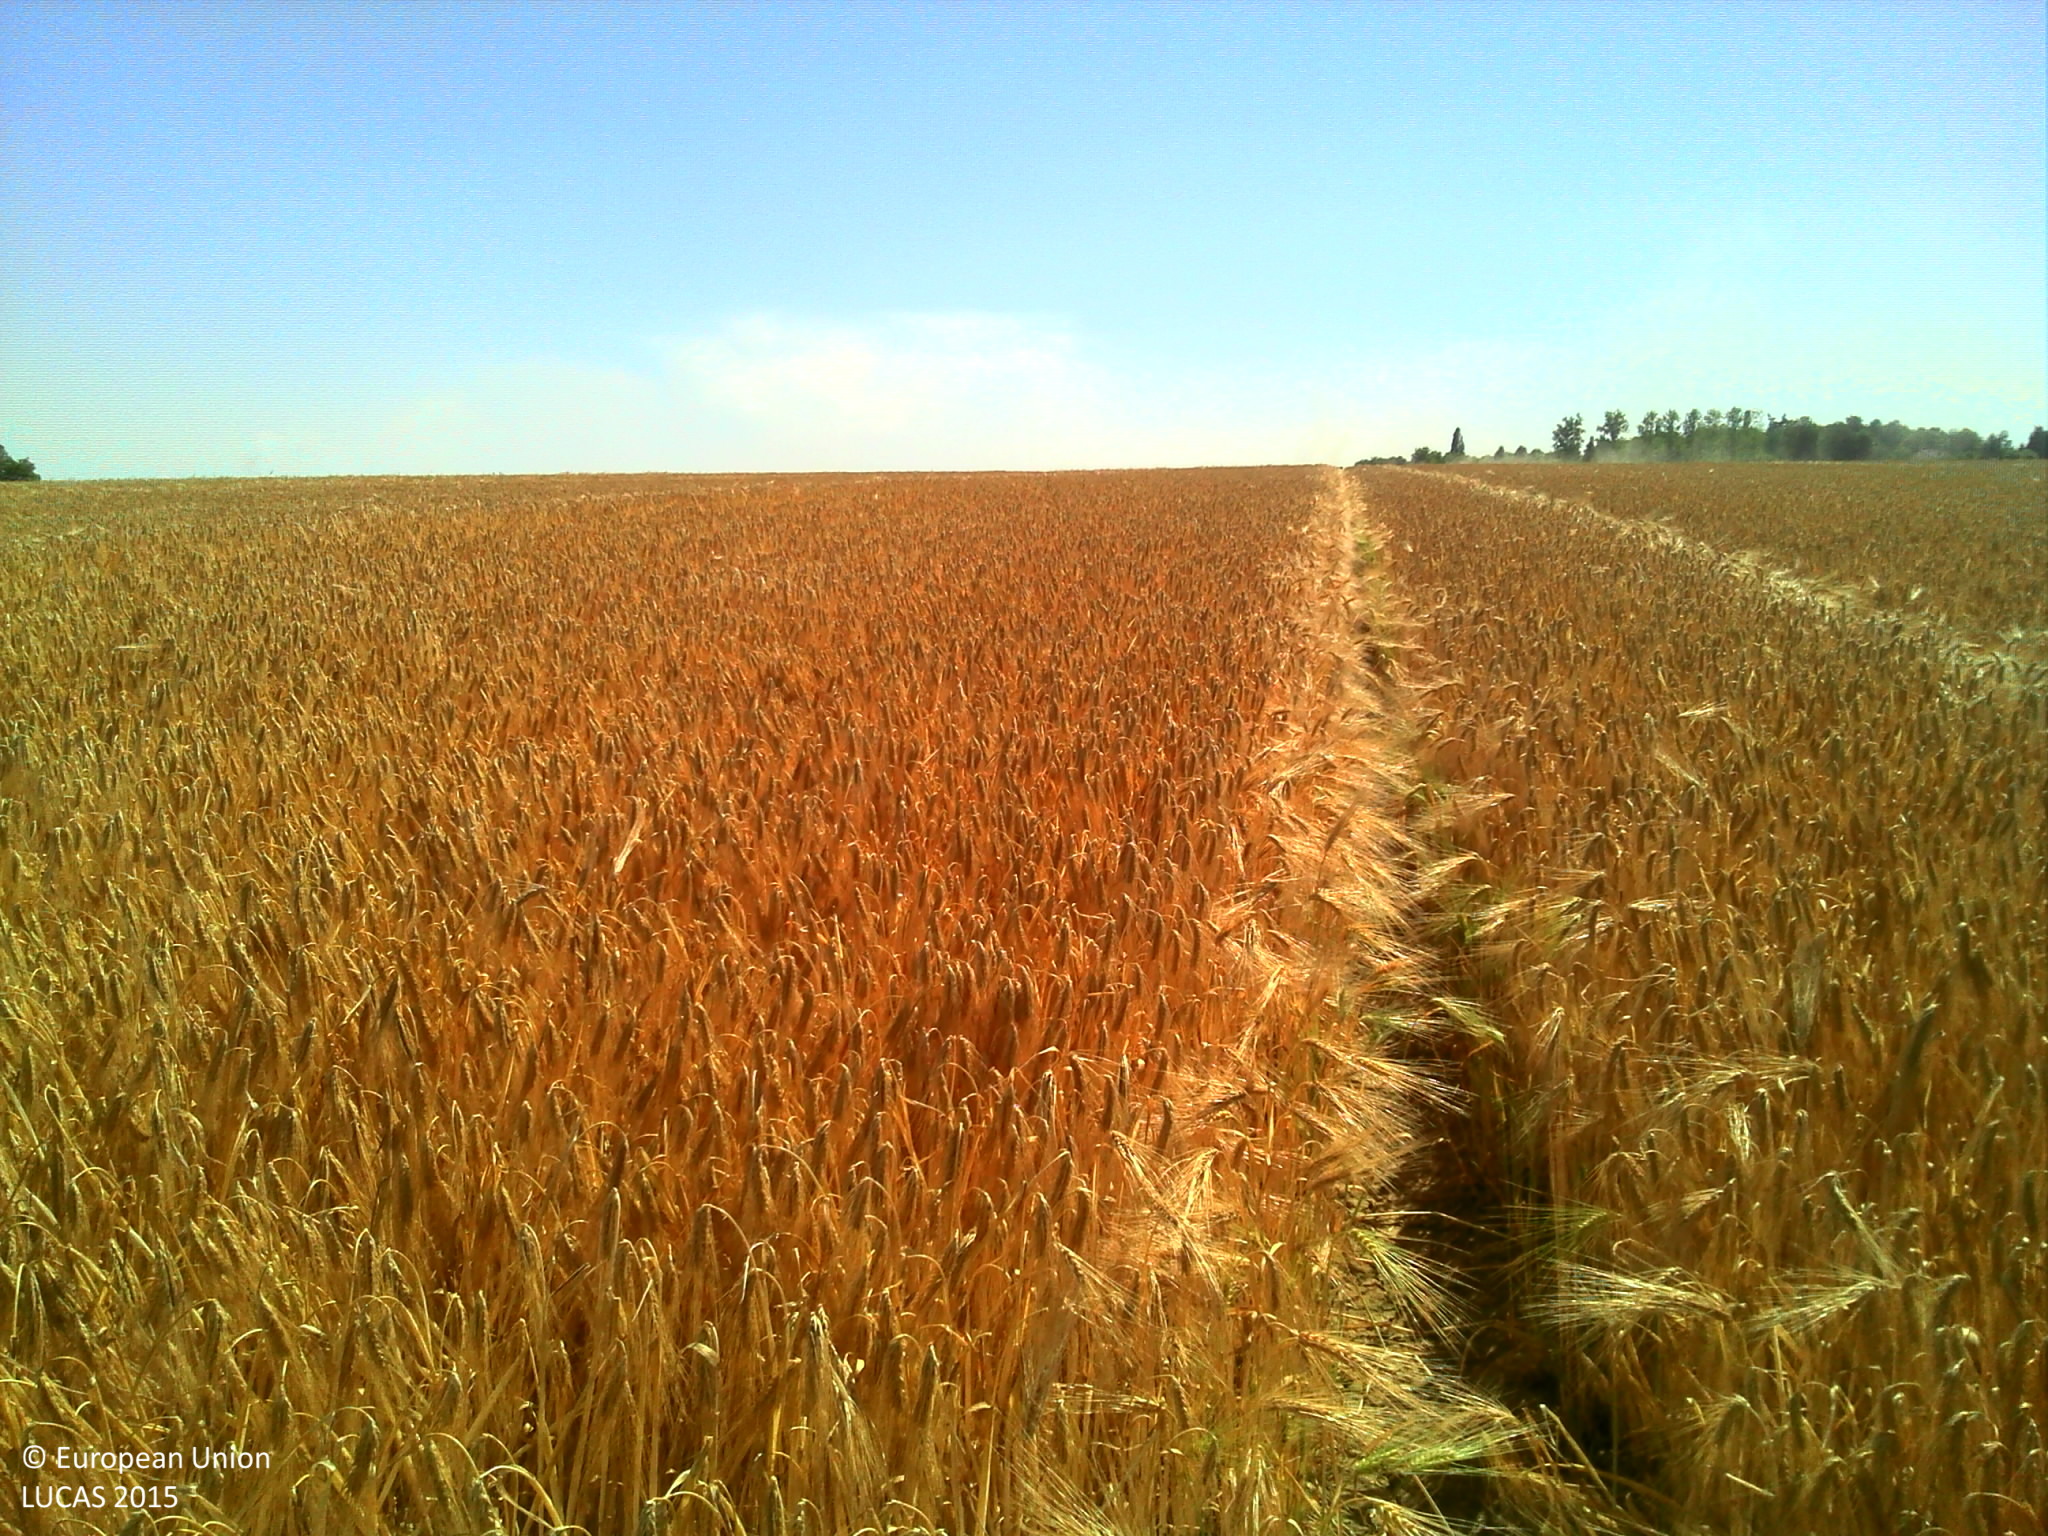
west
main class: Cropland
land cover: Barley
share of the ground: > 75 %
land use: Agriculture (excluding fallow land and kitchen gardens)
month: June
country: FR
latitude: 48.9789
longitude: 1.2497
